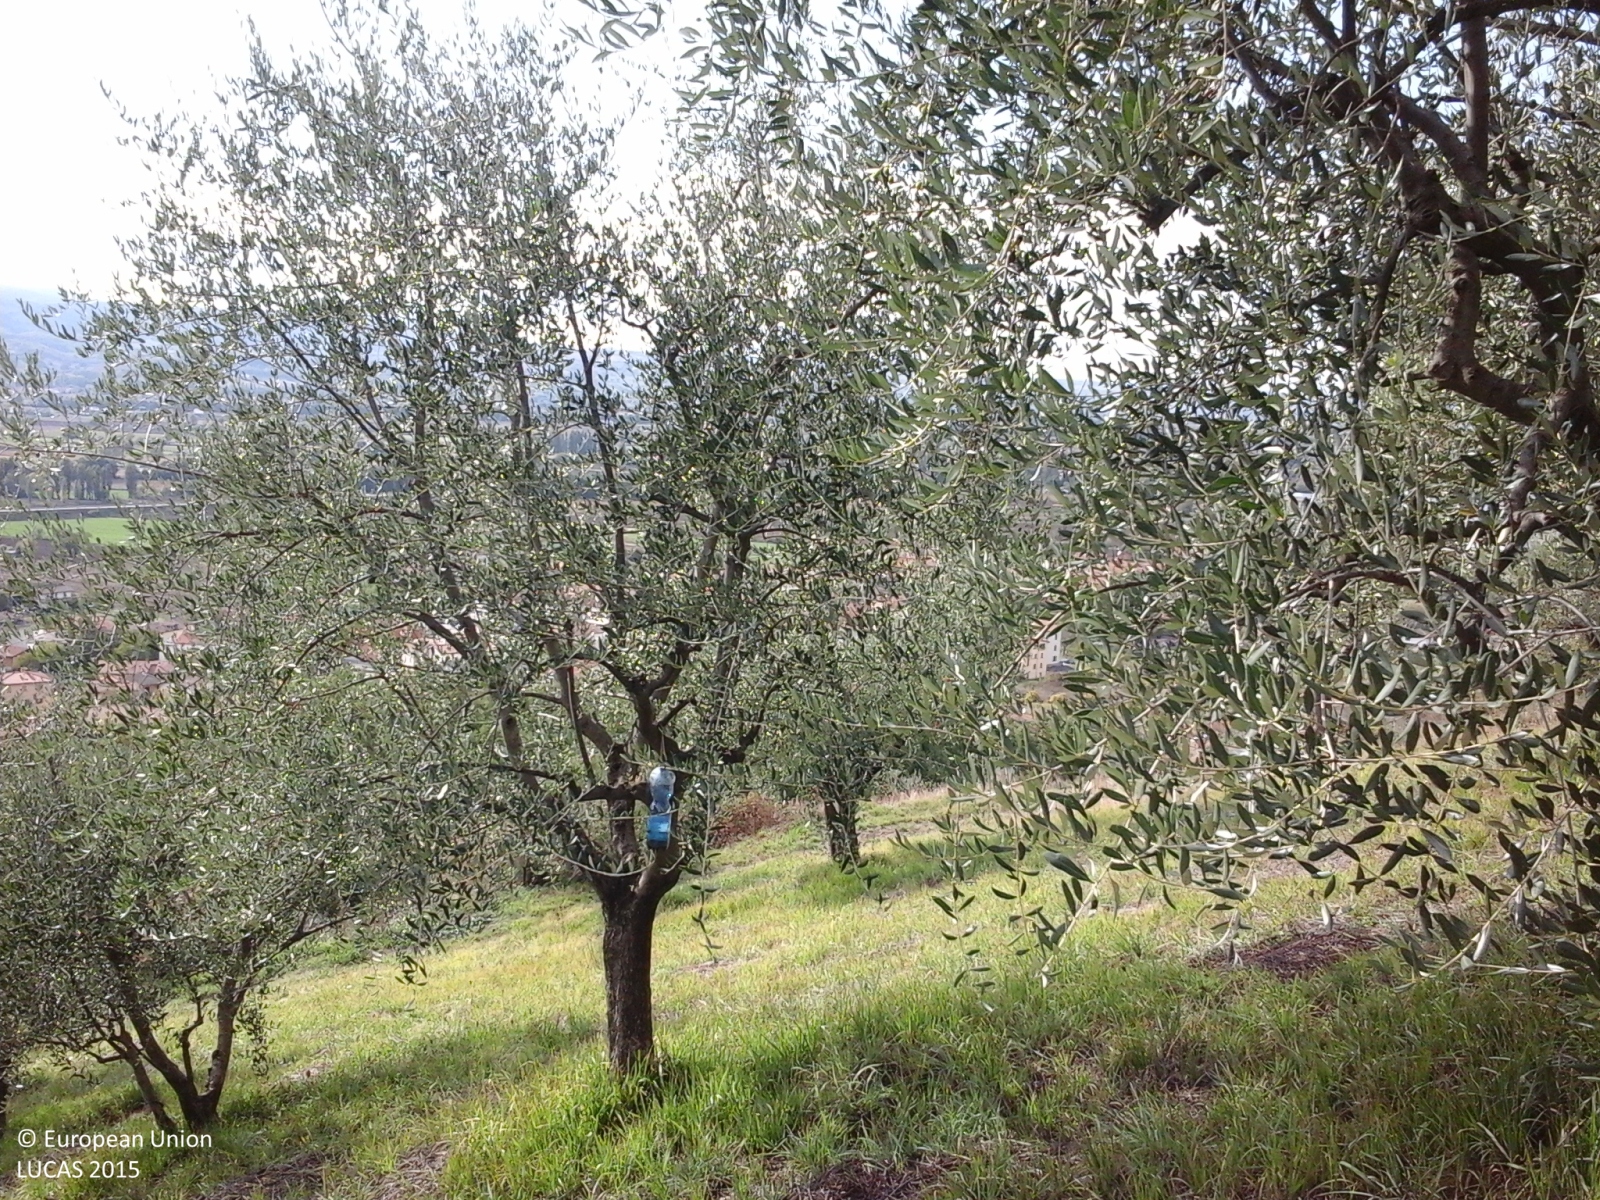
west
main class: Cropland
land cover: Olive groves
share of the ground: 50 - 75 %
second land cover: Spontaneously vegetated surfaces
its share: > 75 %
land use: Agriculture (excluding fallow land and kitchen gardens)
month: October
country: IT
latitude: 43.3247
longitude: 12.6196
